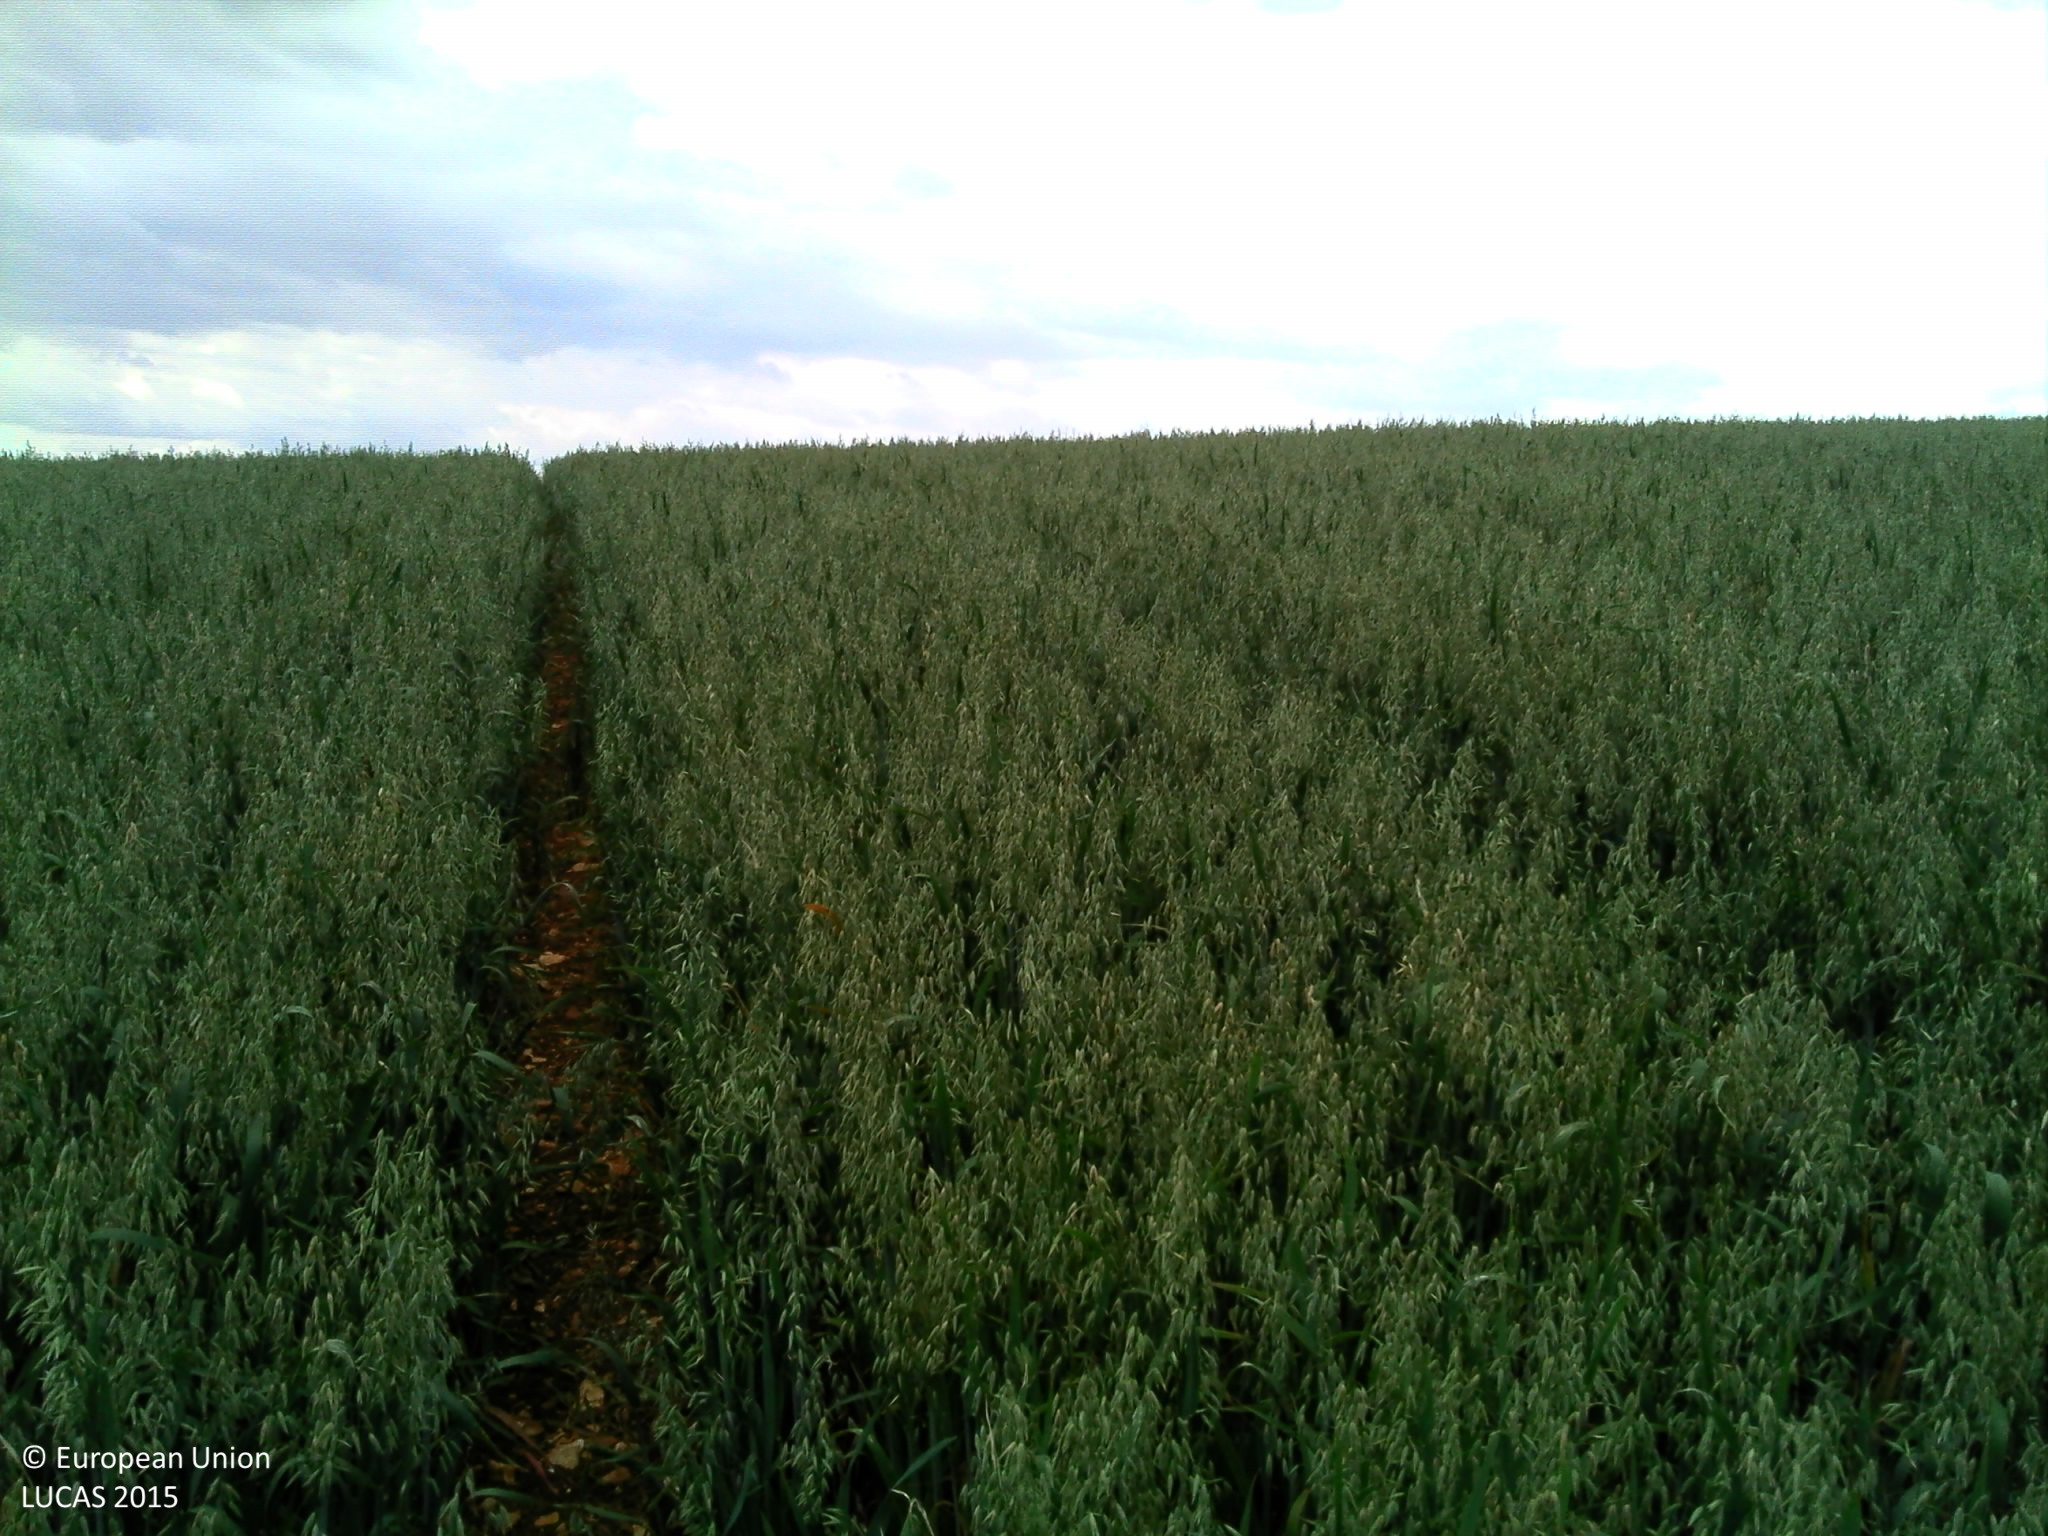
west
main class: Cropland
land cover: Oats
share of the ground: > 75 %
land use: Agriculture (excluding fallow land and kitchen gardens)
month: June
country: FR
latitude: 47.3781
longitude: 3.1477
